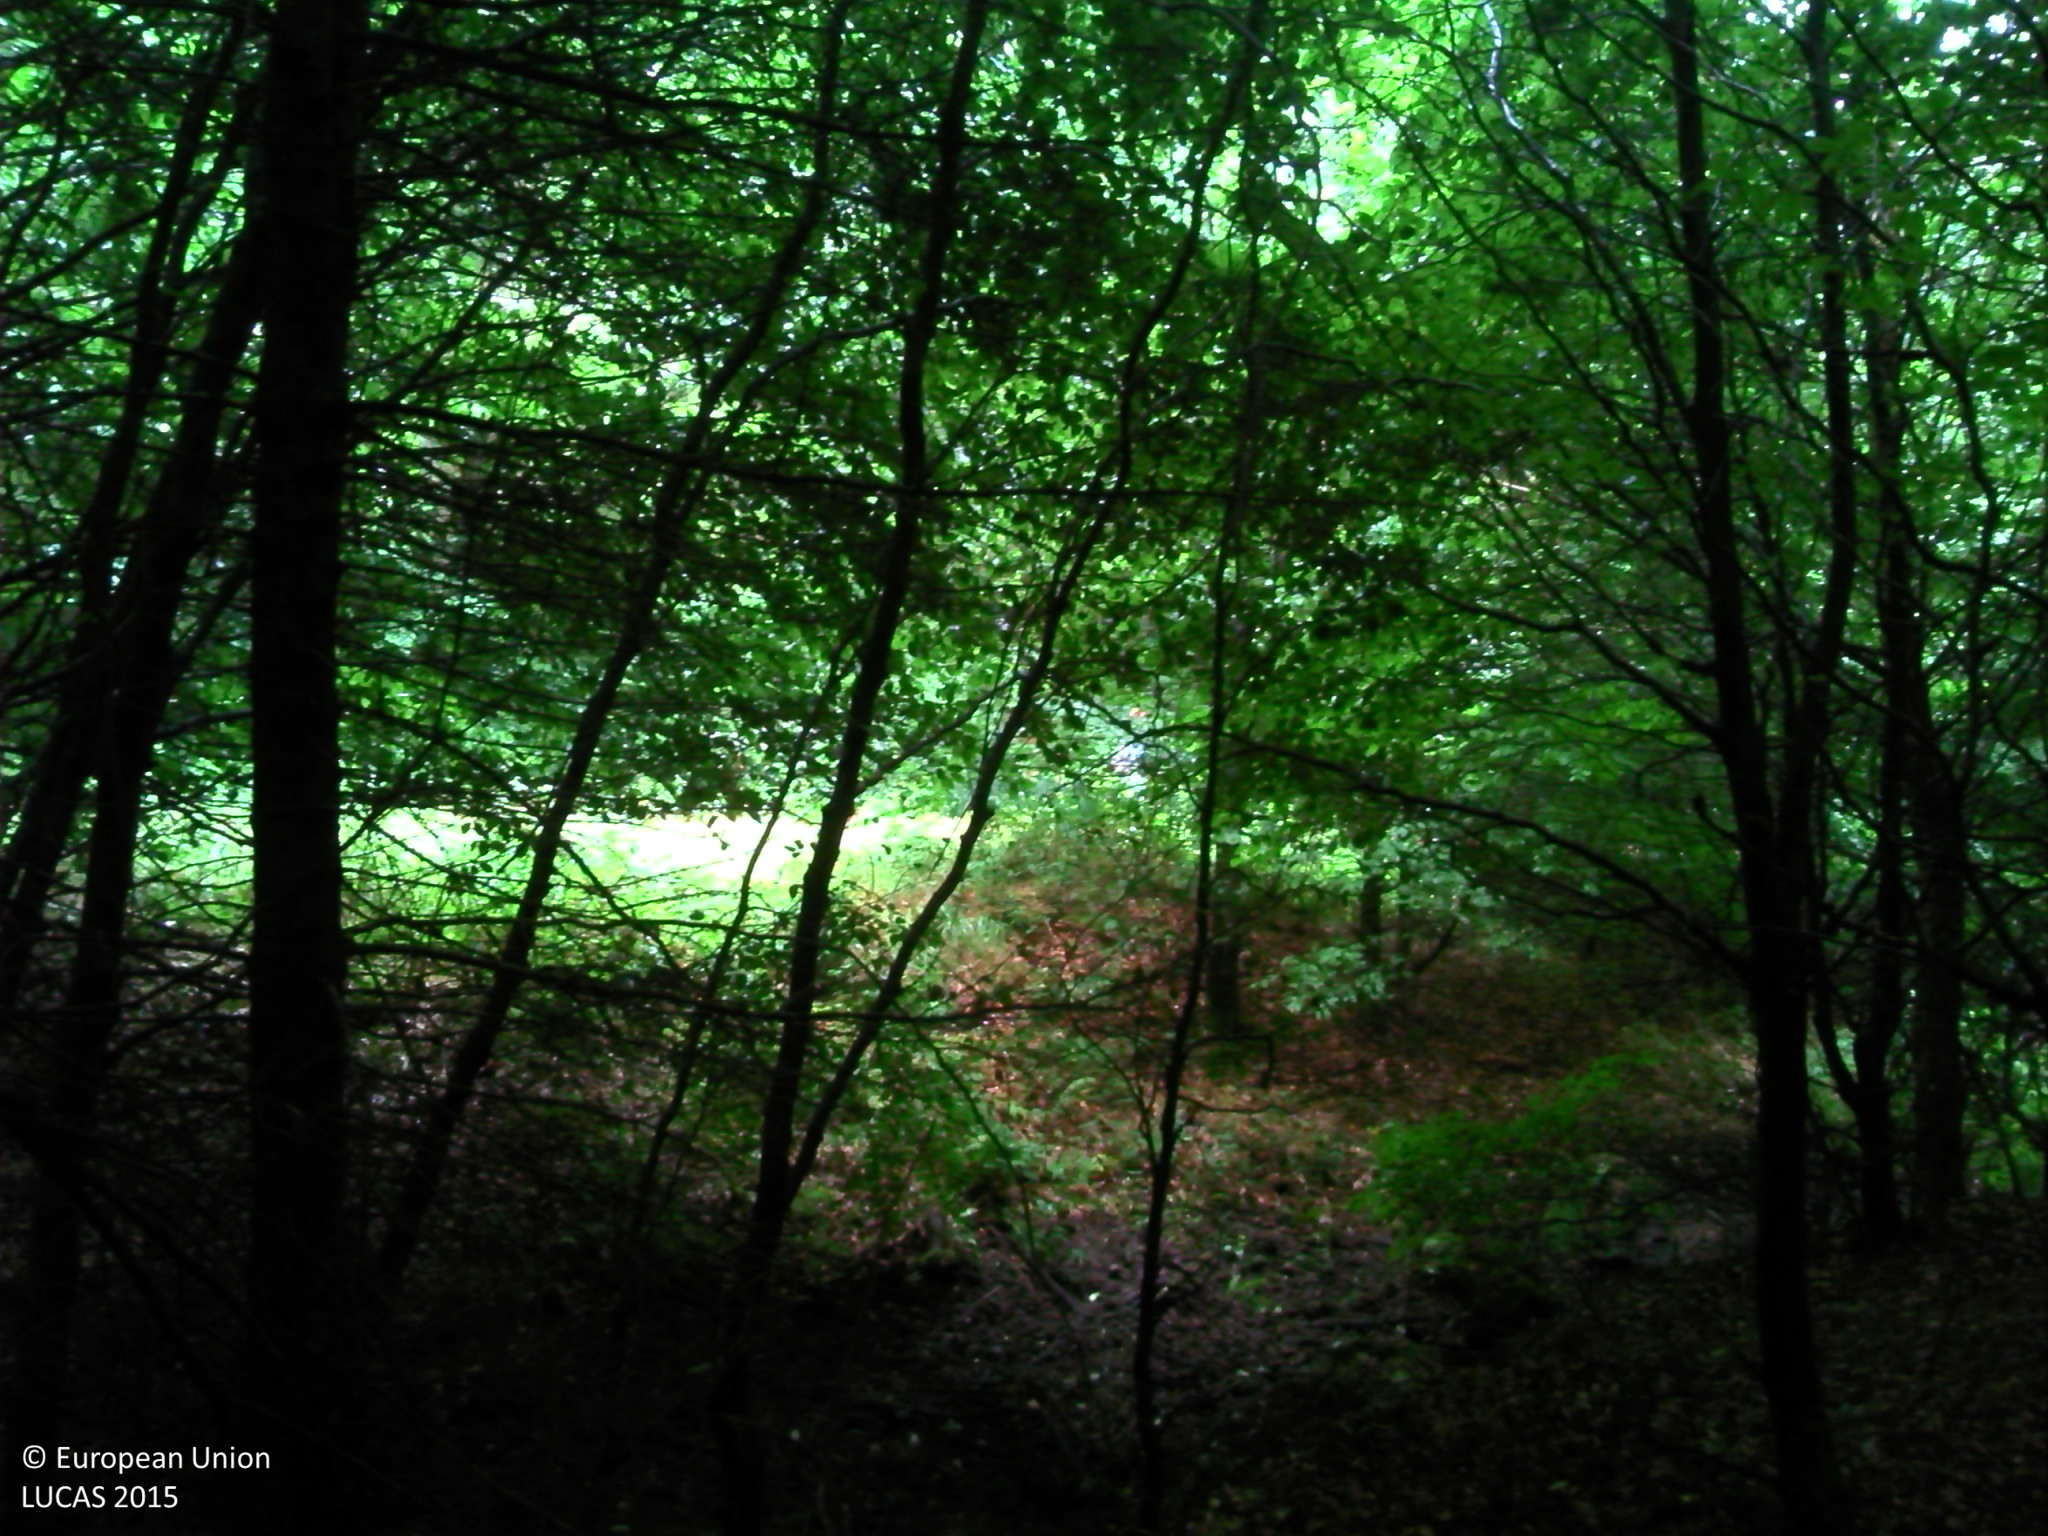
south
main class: Woodland
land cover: Broadleaved woodland
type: beech forest
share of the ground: > 75 %
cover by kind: broadleaved forest trees 100 %
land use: Forestry
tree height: > 5 m
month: July
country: FR
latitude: 48.9711
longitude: 7.5826
